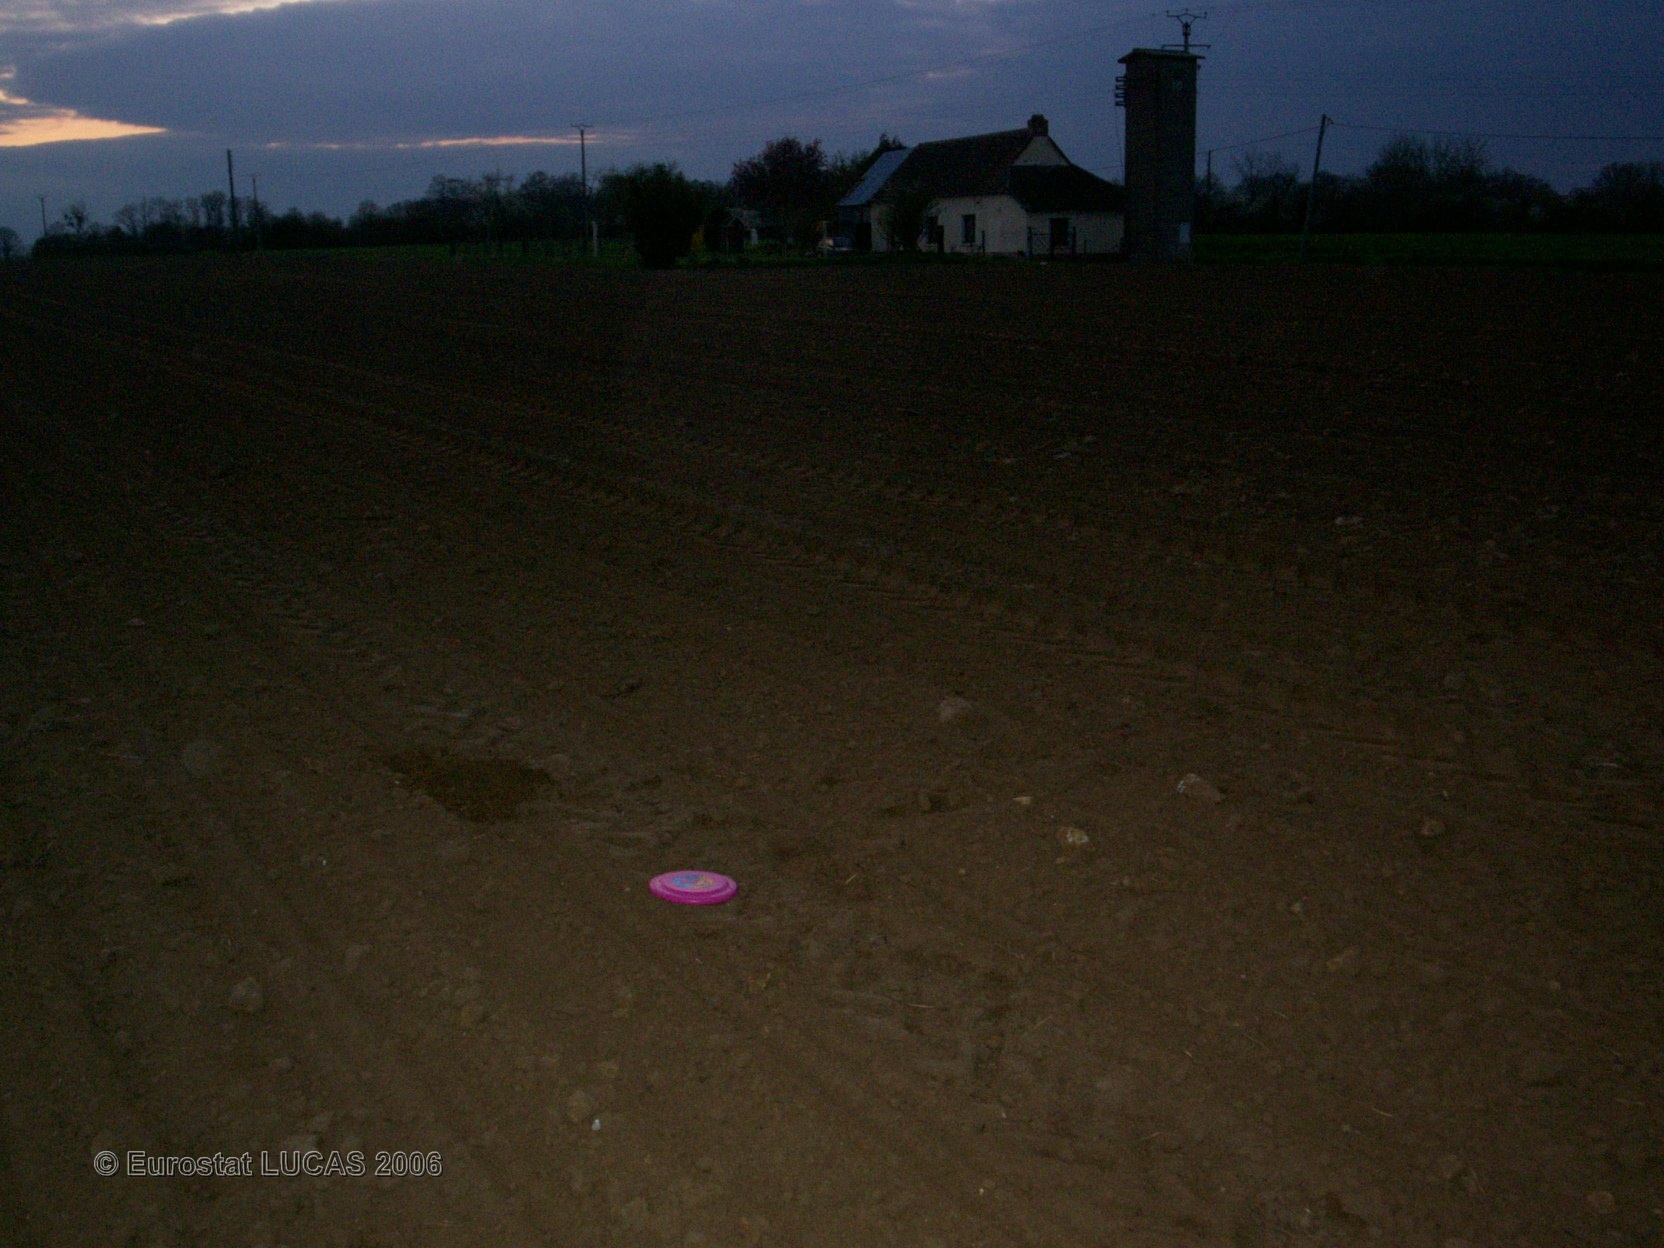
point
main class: Cropland
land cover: Maize
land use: Agriculture (excluding fallow land and kitchen gardens)
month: April
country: FR
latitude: 48.2863
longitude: 0.1204
